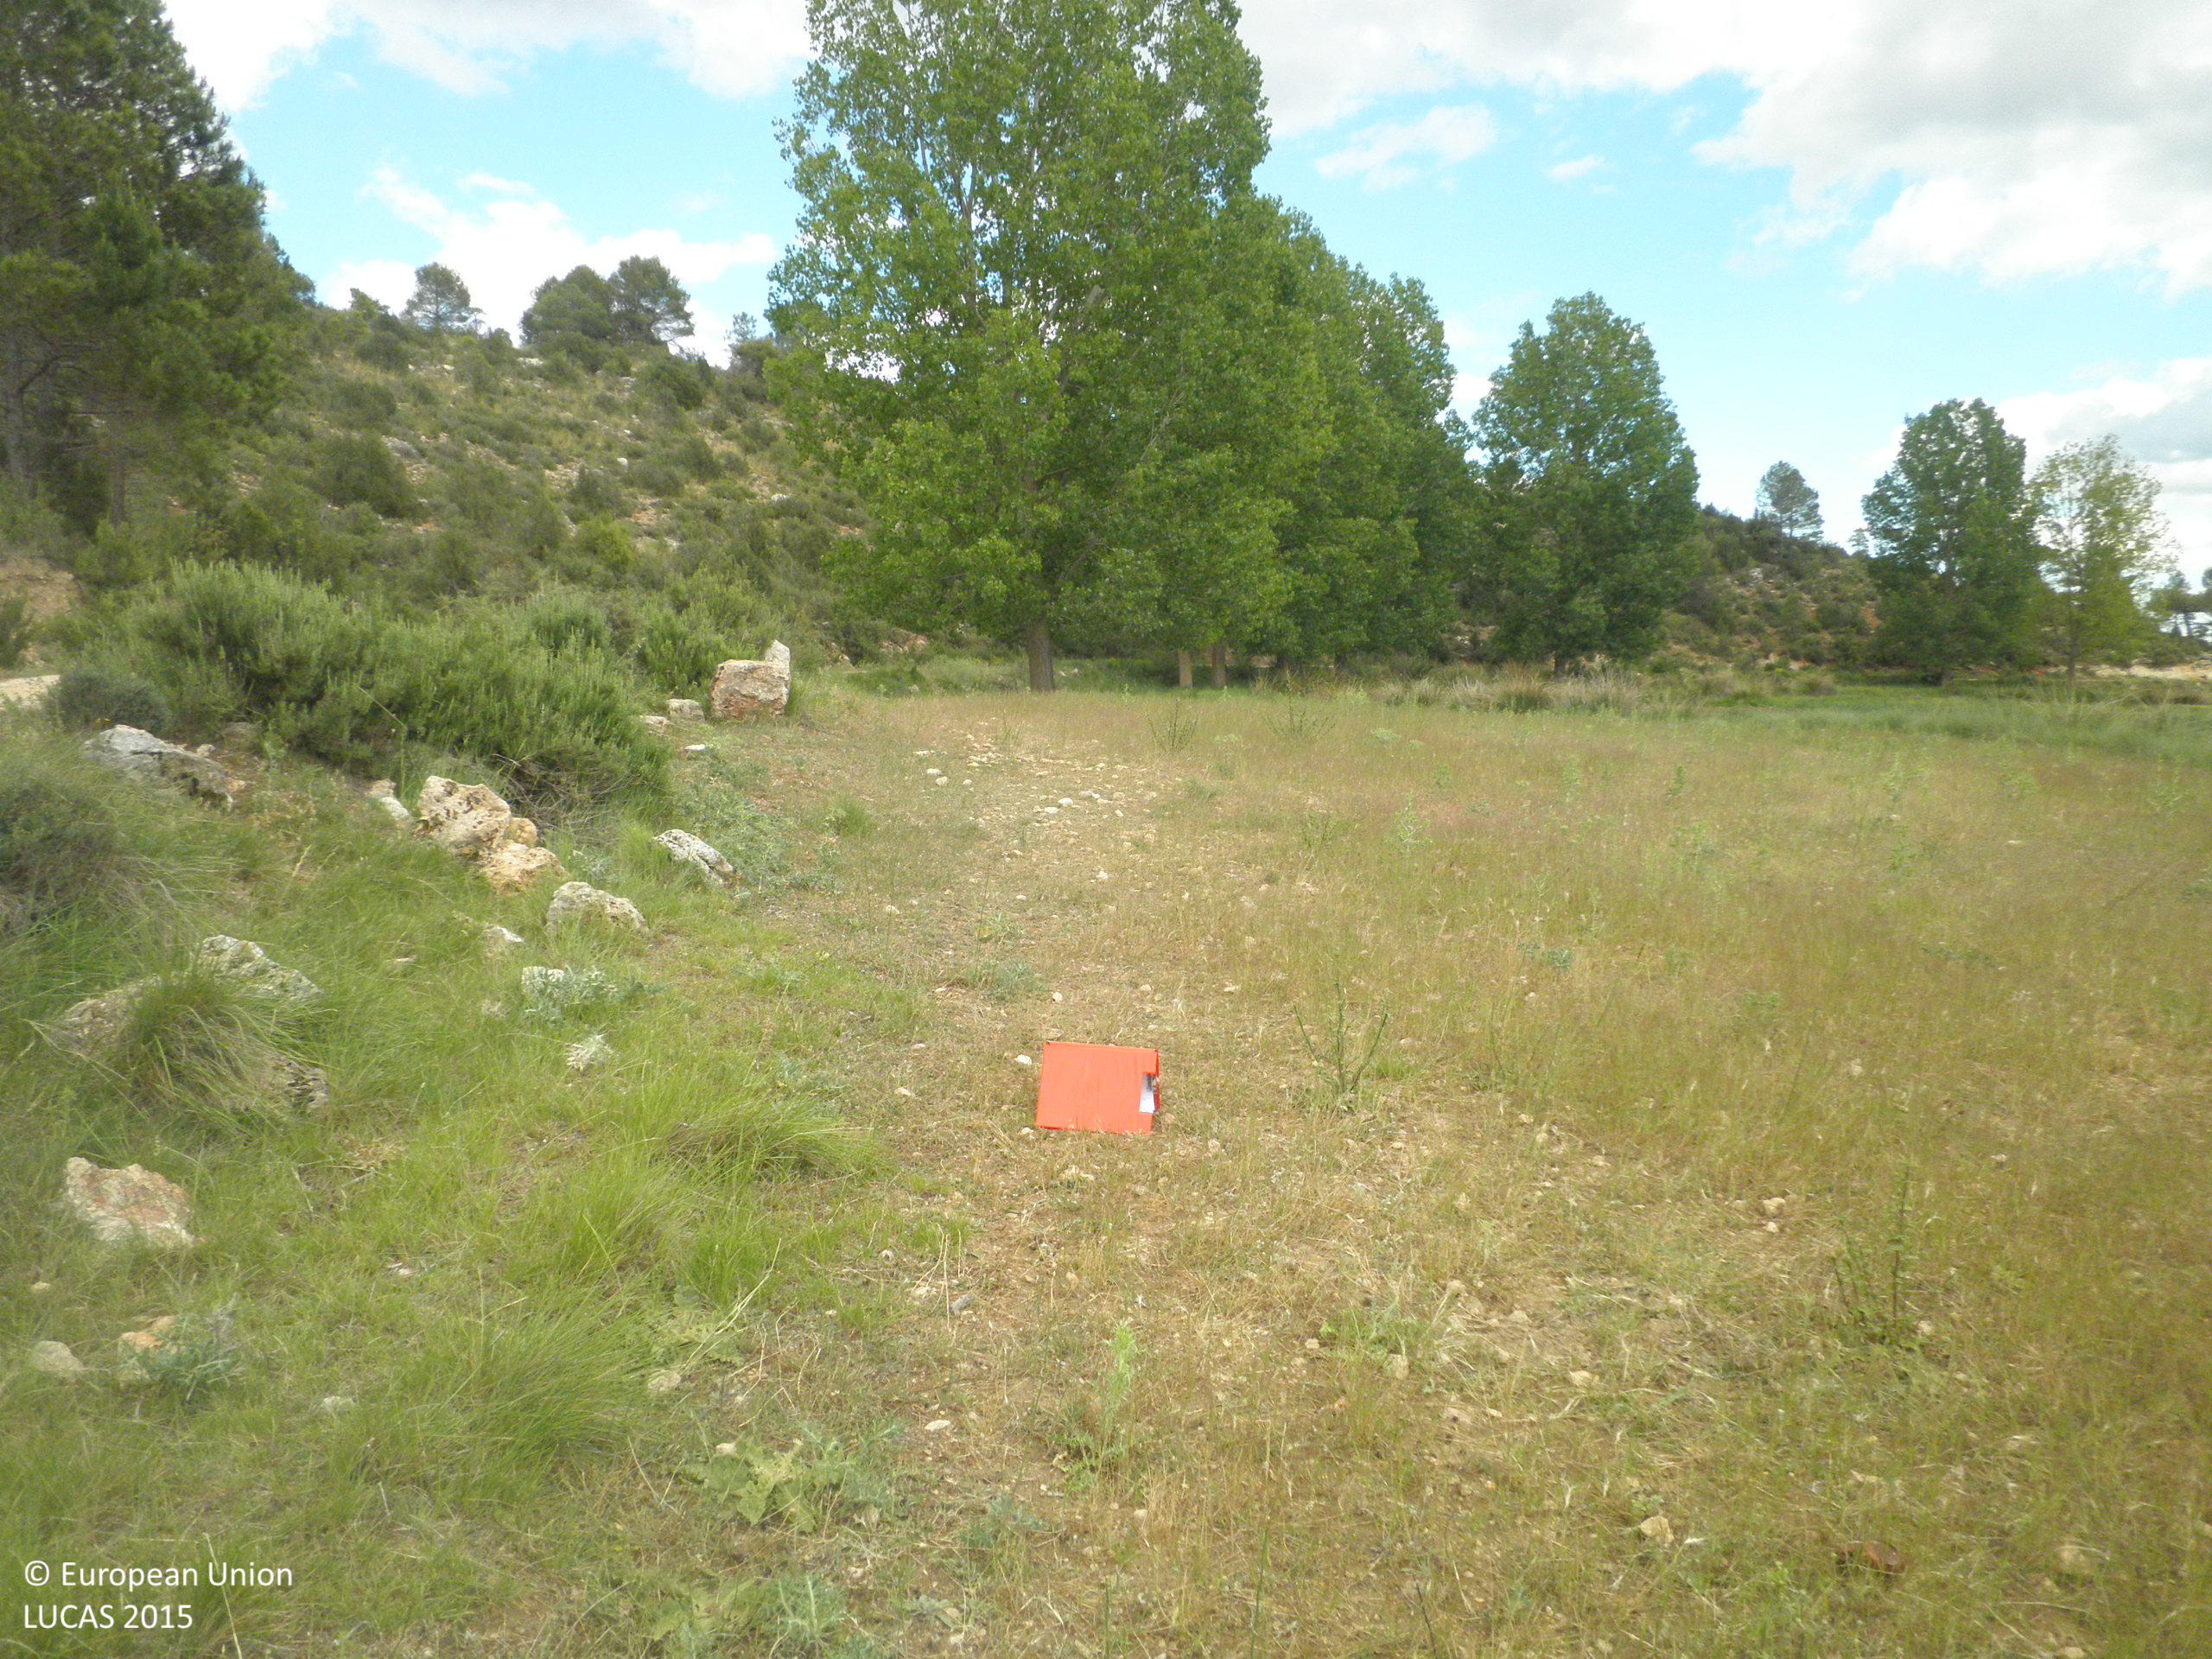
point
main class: Grassland
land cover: Spontaneously vegetated surfaces
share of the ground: > 75 %
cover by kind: herbaceous plants 90 %, unconsolidated bare surface 10 %
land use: Abandoned areas
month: June
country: ES
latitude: 39.7966
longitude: -1.7464
